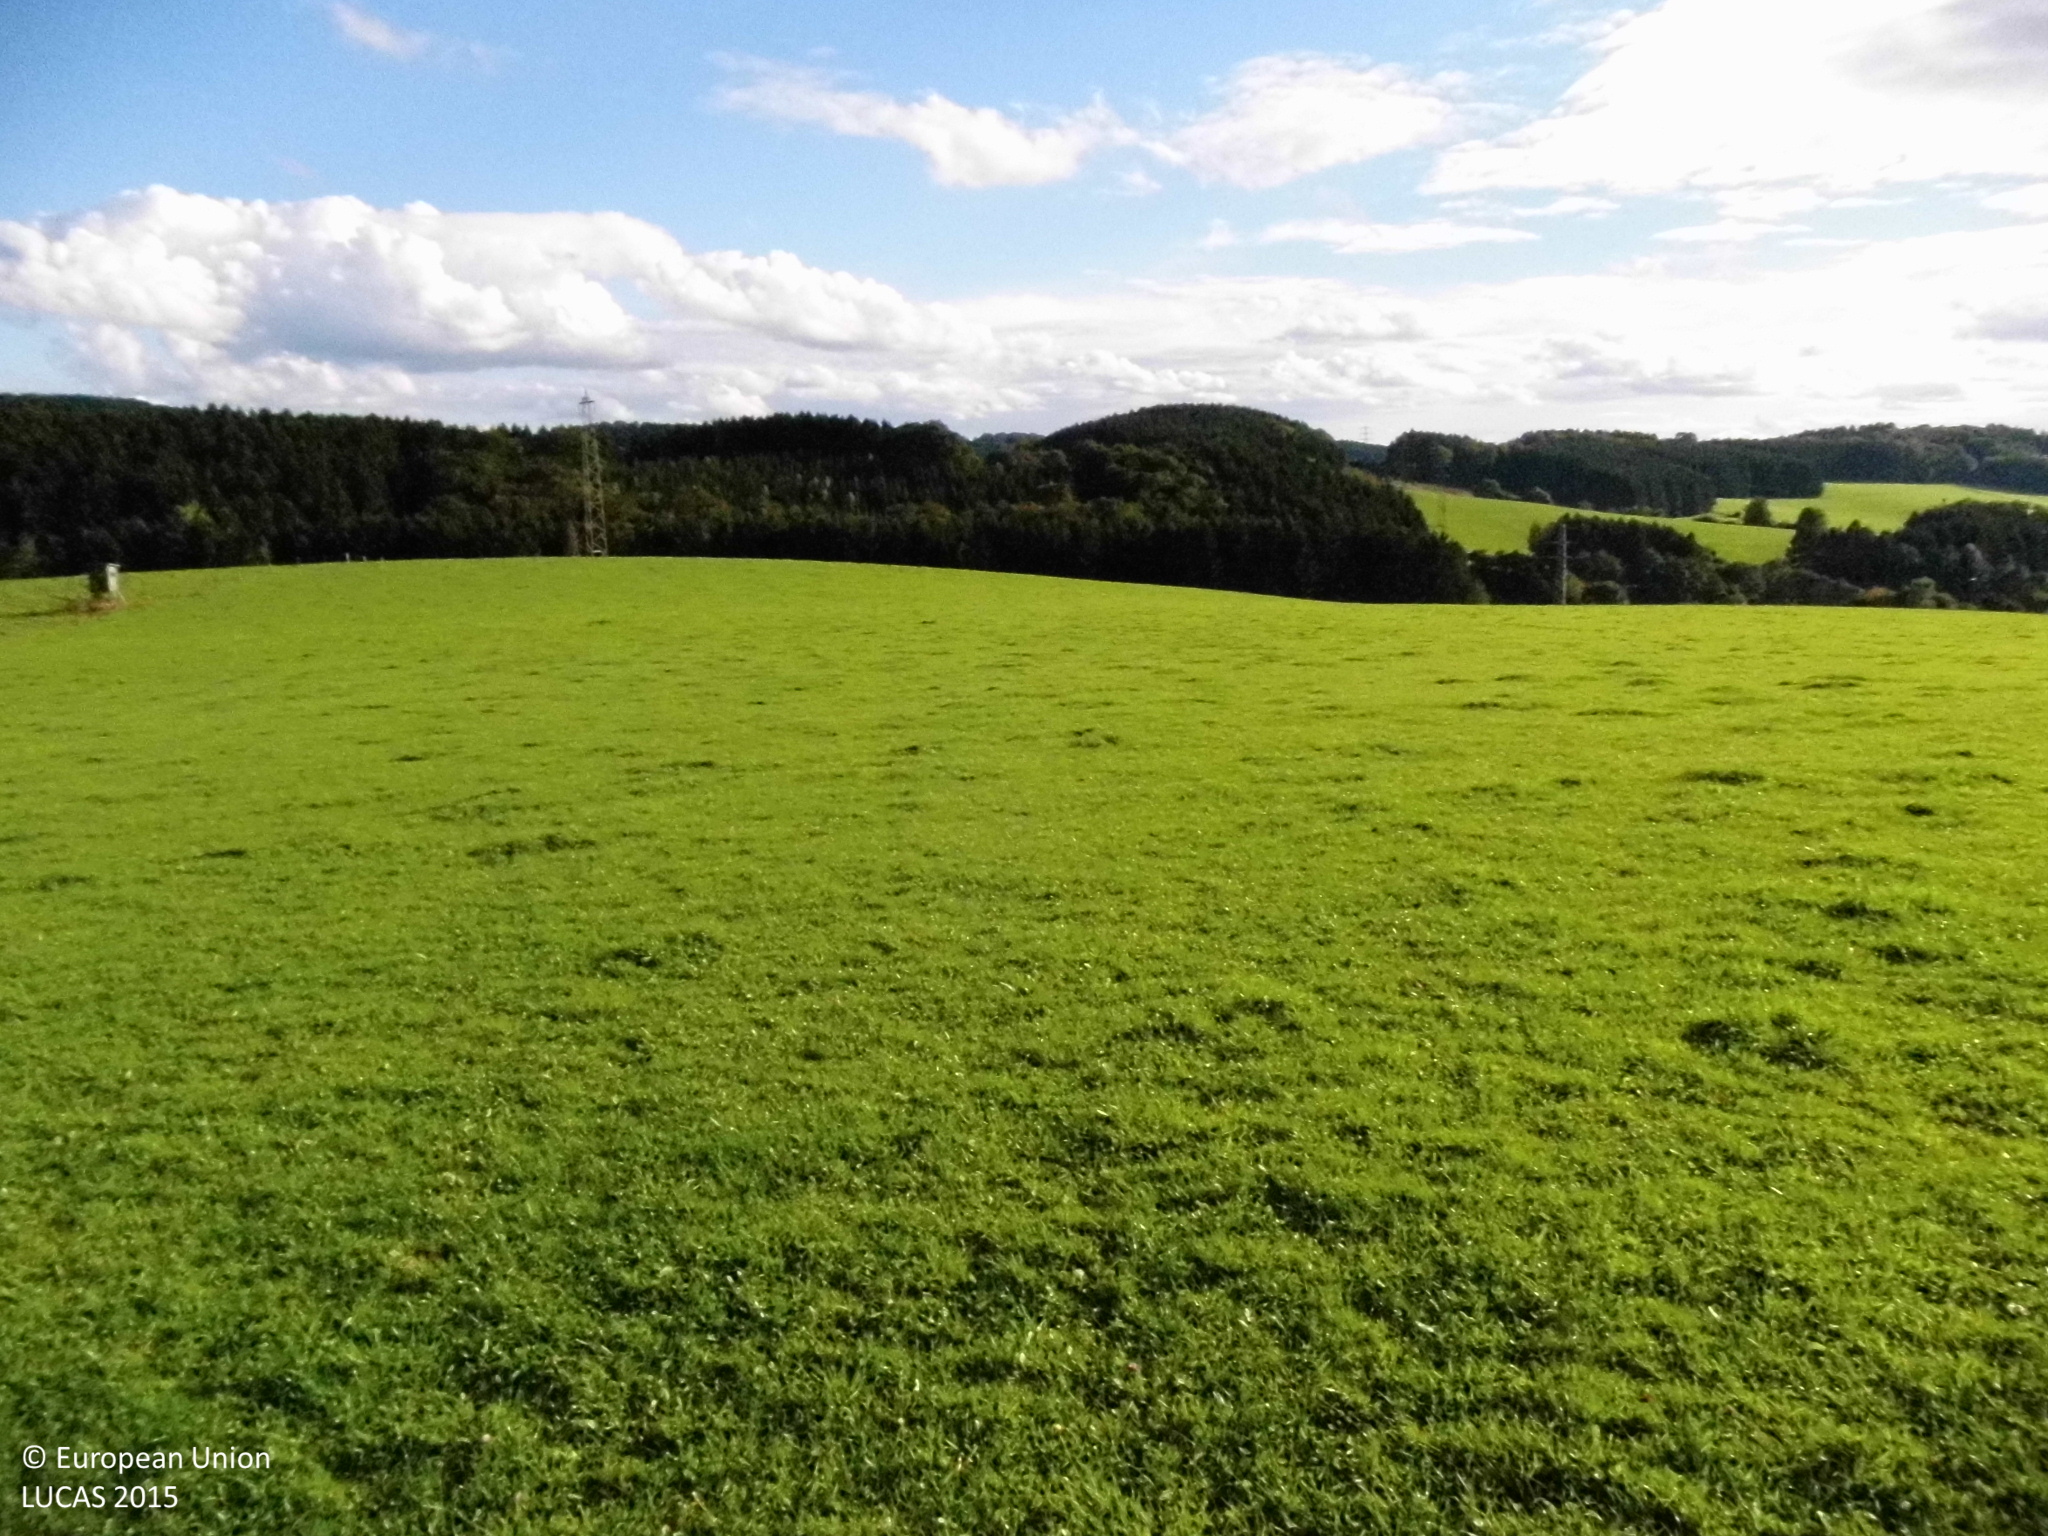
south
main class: Grassland
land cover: Grassland without tree/shrub cover
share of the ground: > 75 %
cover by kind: herbaceous plants 100 %
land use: Agriculture (excluding fallow land and kitchen gardens)
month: September
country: DE
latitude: 51.0551
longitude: 7.4465
